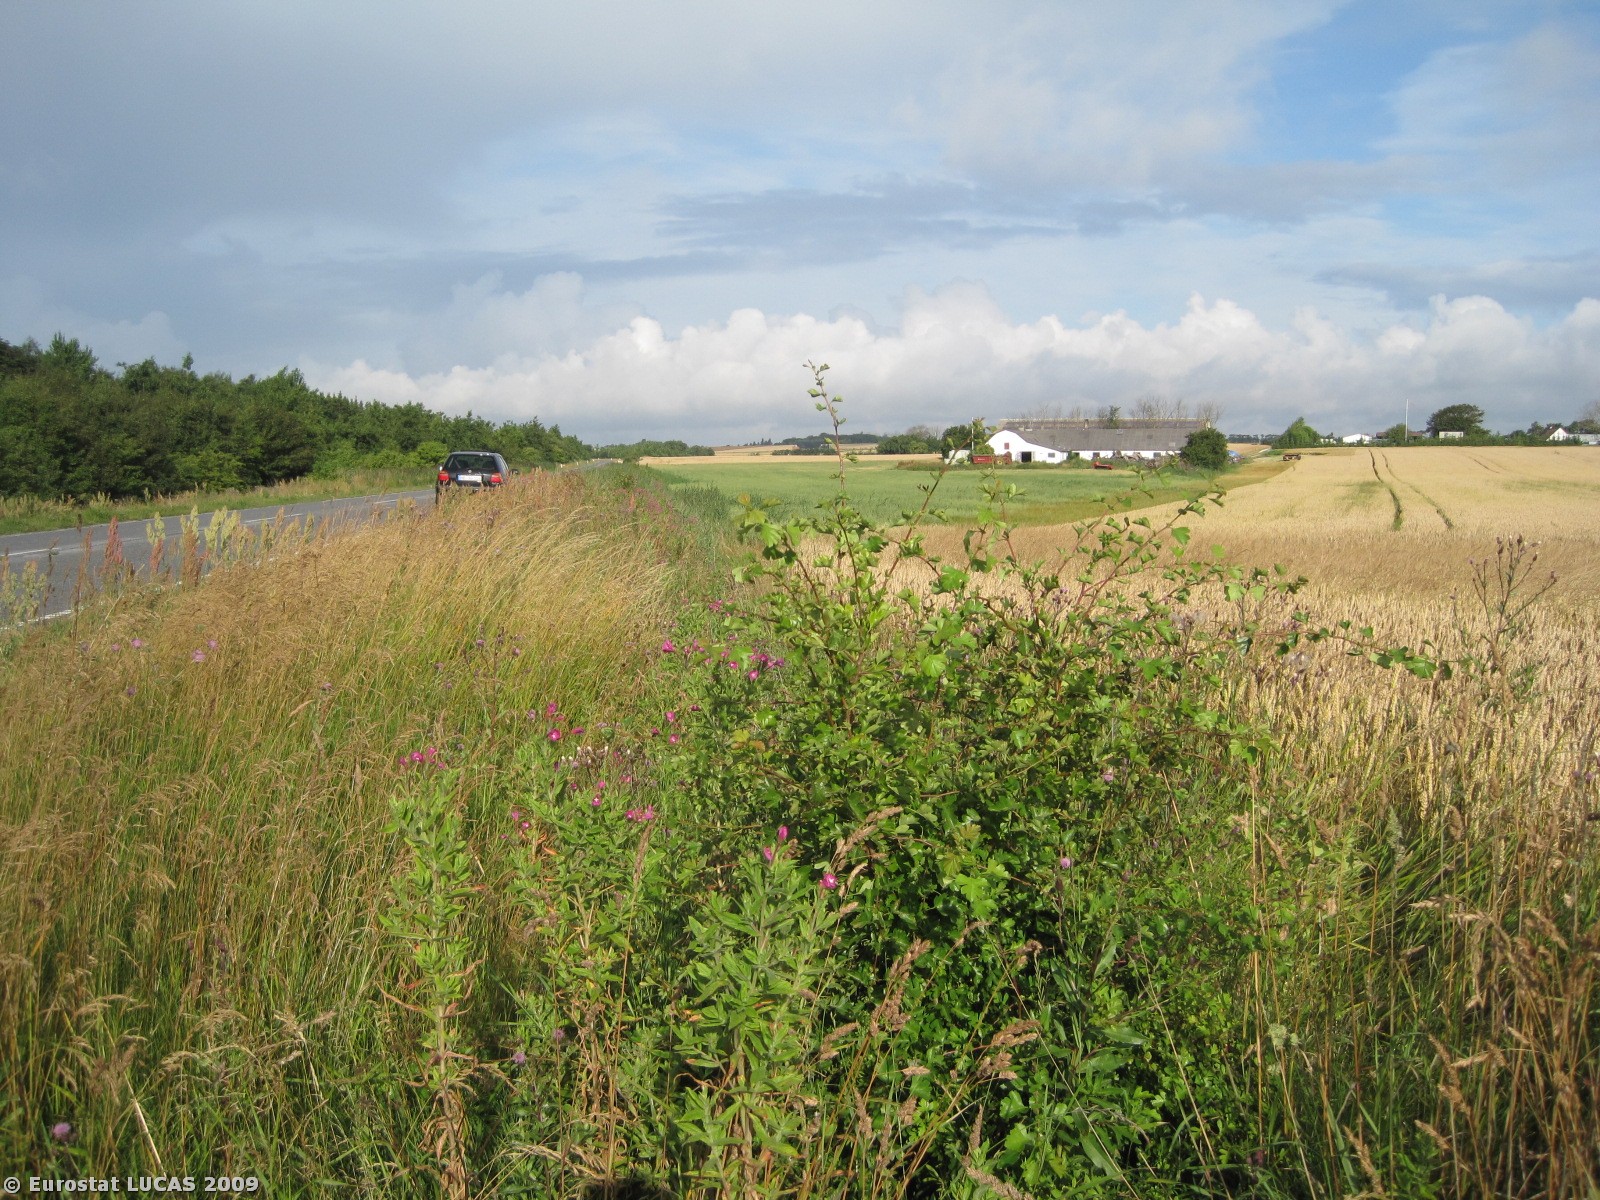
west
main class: Cropland
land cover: Common wheat
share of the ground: > 75 %
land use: Agriculture (excluding fallow land and kitchen gardens)
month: July
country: DK
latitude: 57.0106
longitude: 8.9641
